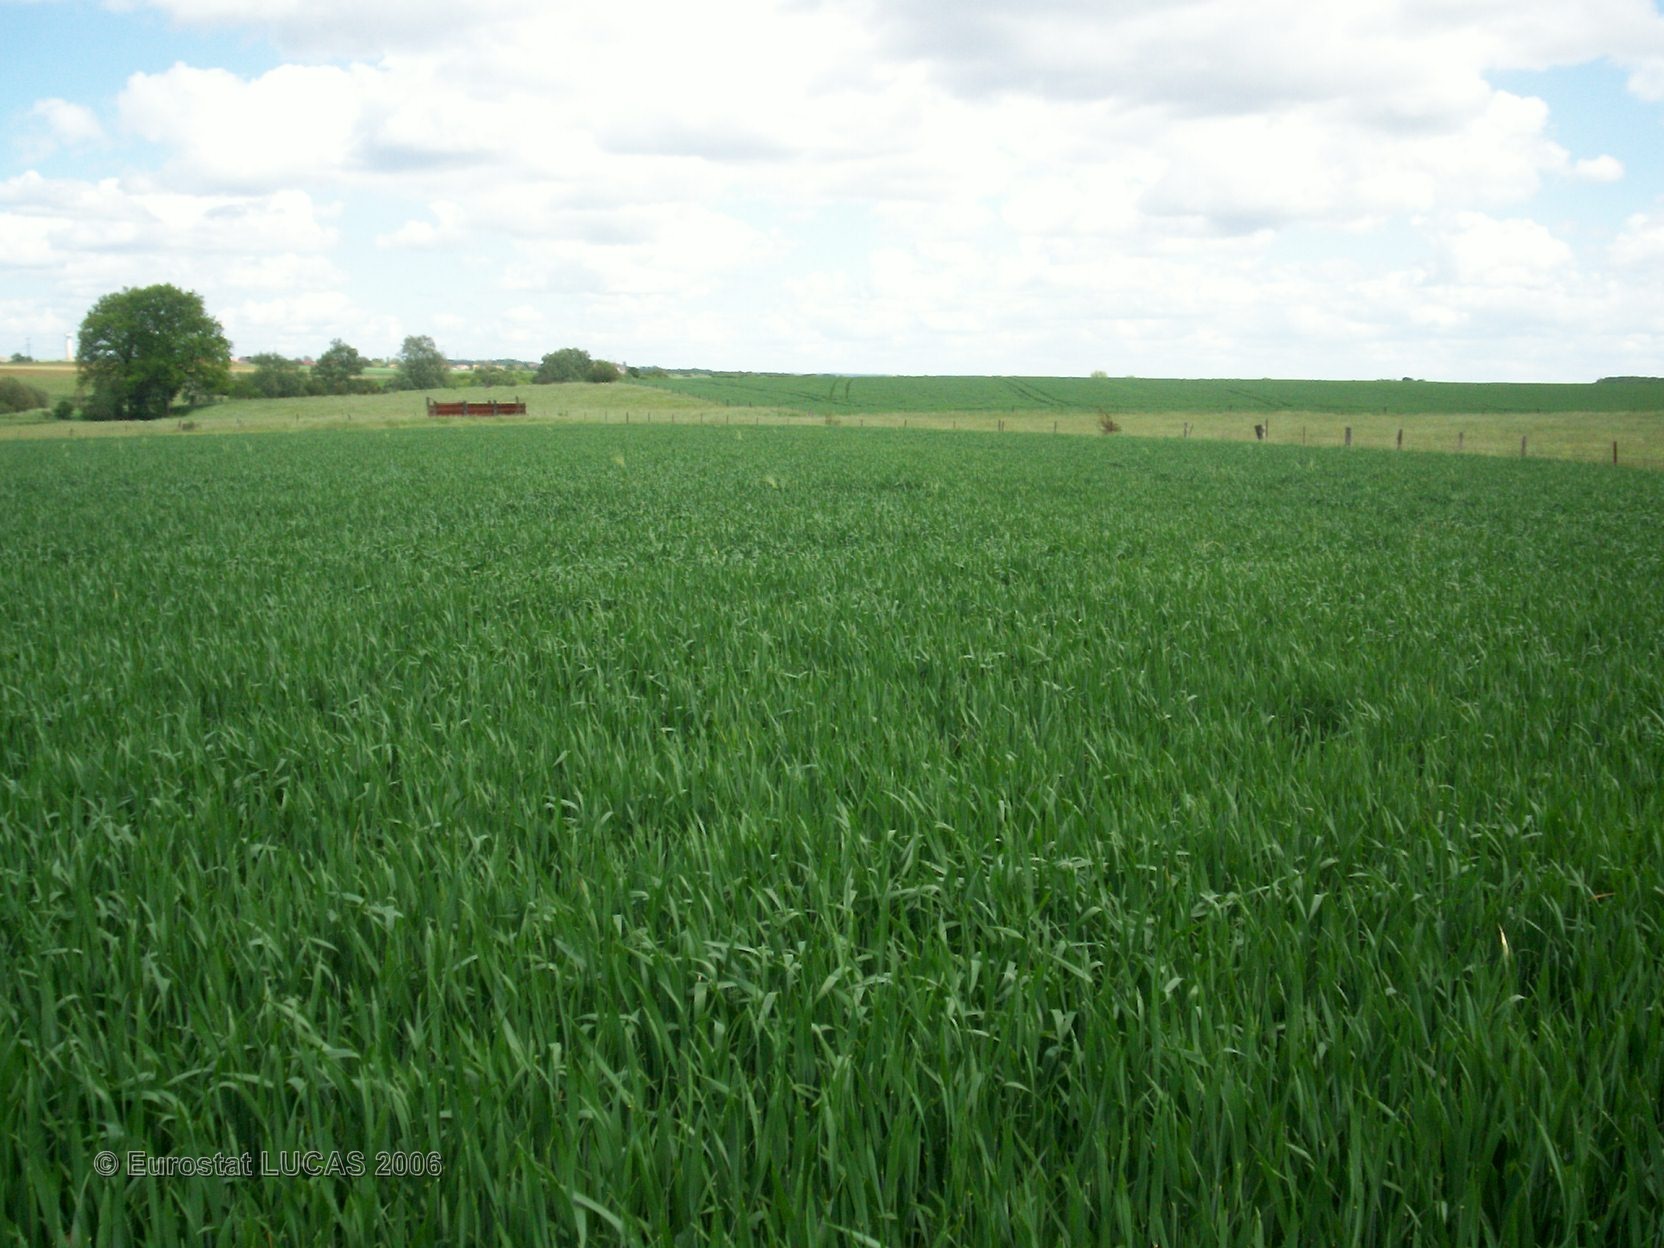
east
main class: Cropland
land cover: Common wheat
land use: Agriculture (excluding fallow land and kitchen gardens)
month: May
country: FR
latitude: 49.2269
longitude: 5.8661
